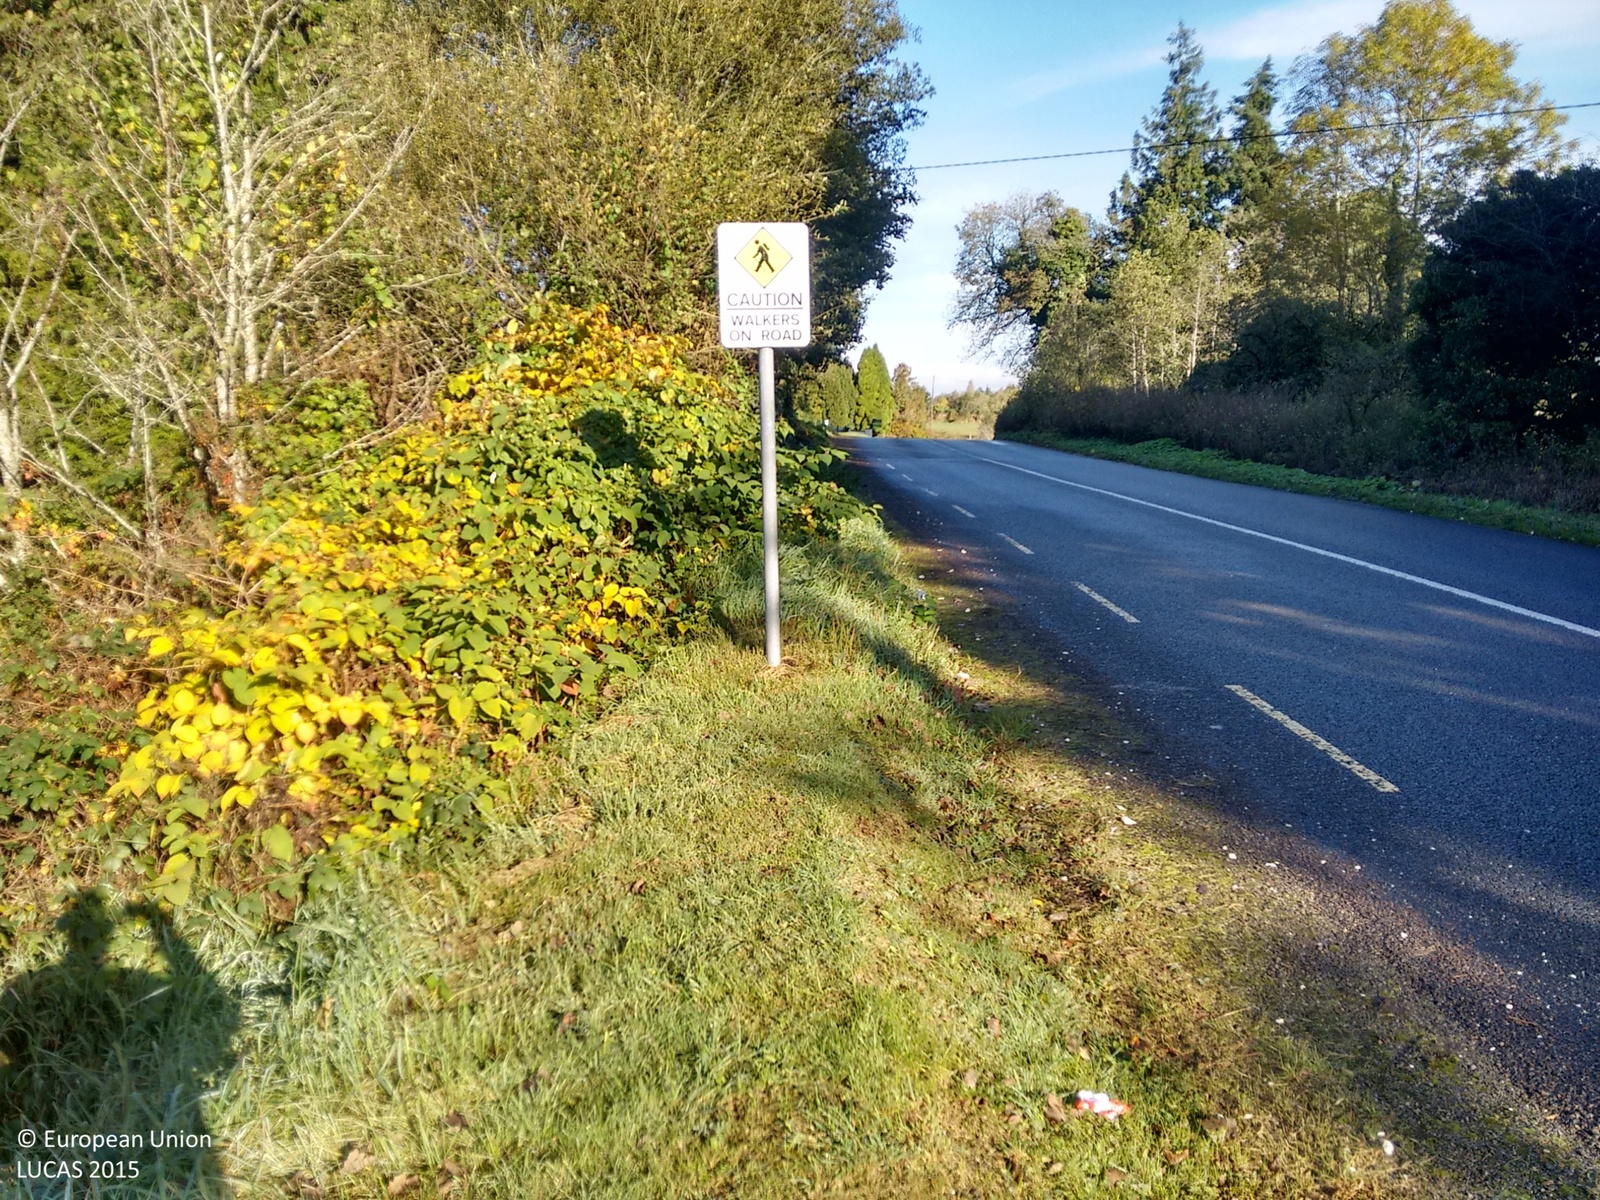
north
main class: Woodland
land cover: Broadleaved woodland
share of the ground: > 75 %
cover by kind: broadleaved forest trees 70 %, shrubs 20 %, herbaceous plants 10 %
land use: Residential
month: October
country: IE
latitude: 54.0917
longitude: -8.0806
